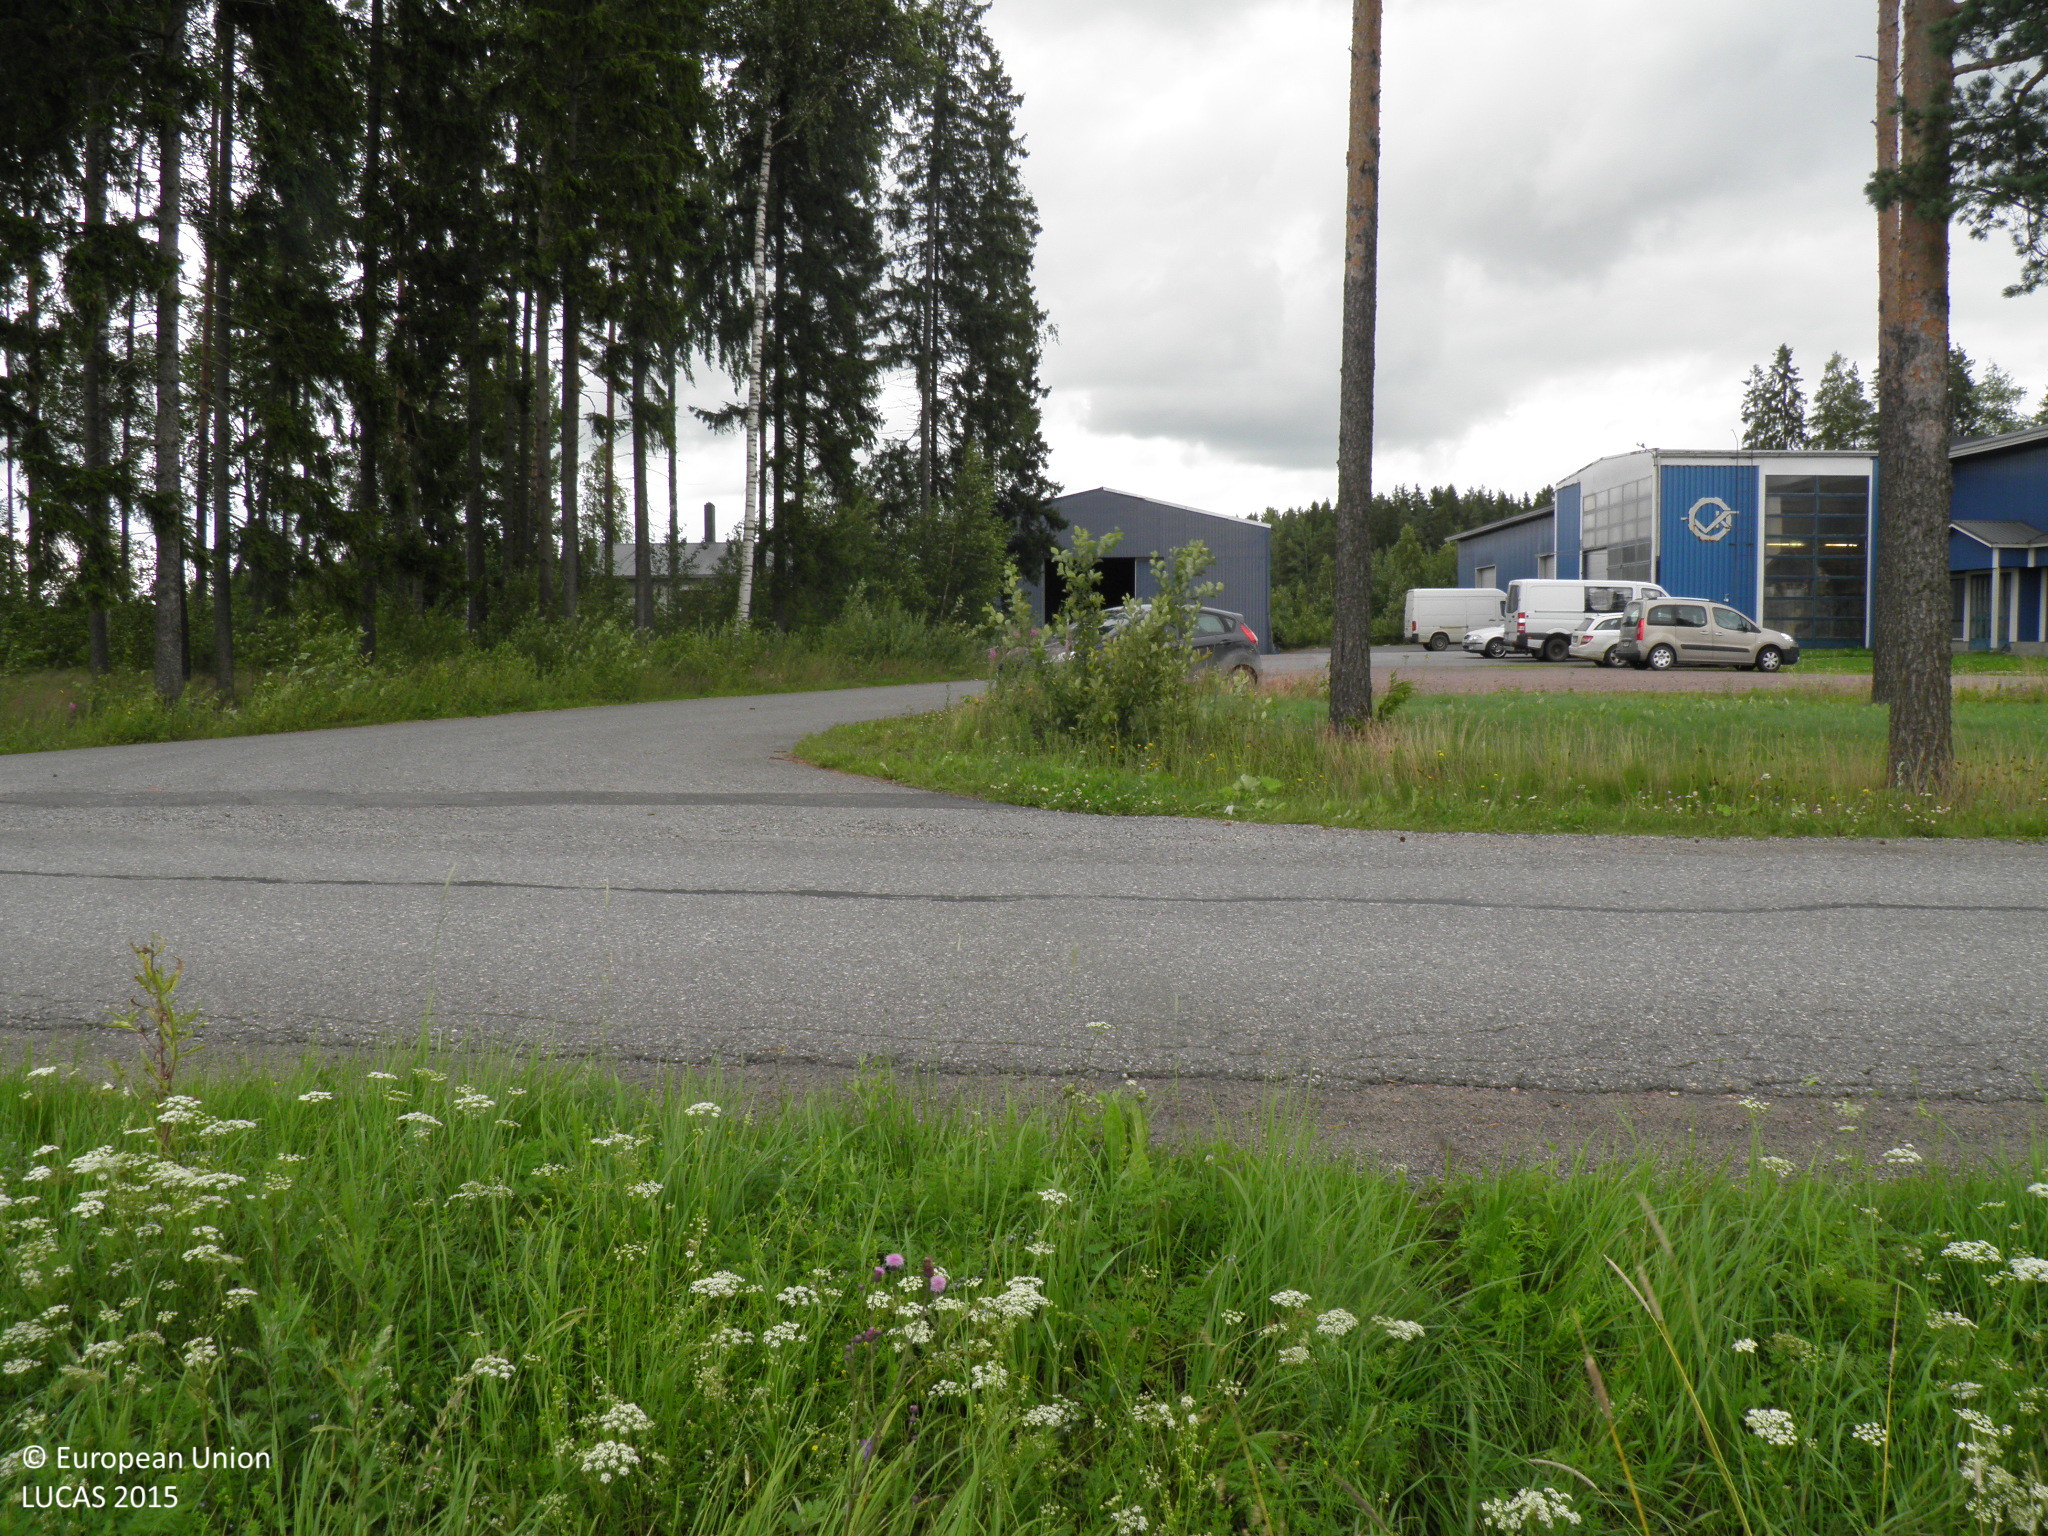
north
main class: Cropland
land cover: Barley
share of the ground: > 75 %
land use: Agriculture (excluding fallow land and kitchen gardens)
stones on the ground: < 10 %
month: July
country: FI
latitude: 60.8786
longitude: 22.9507
